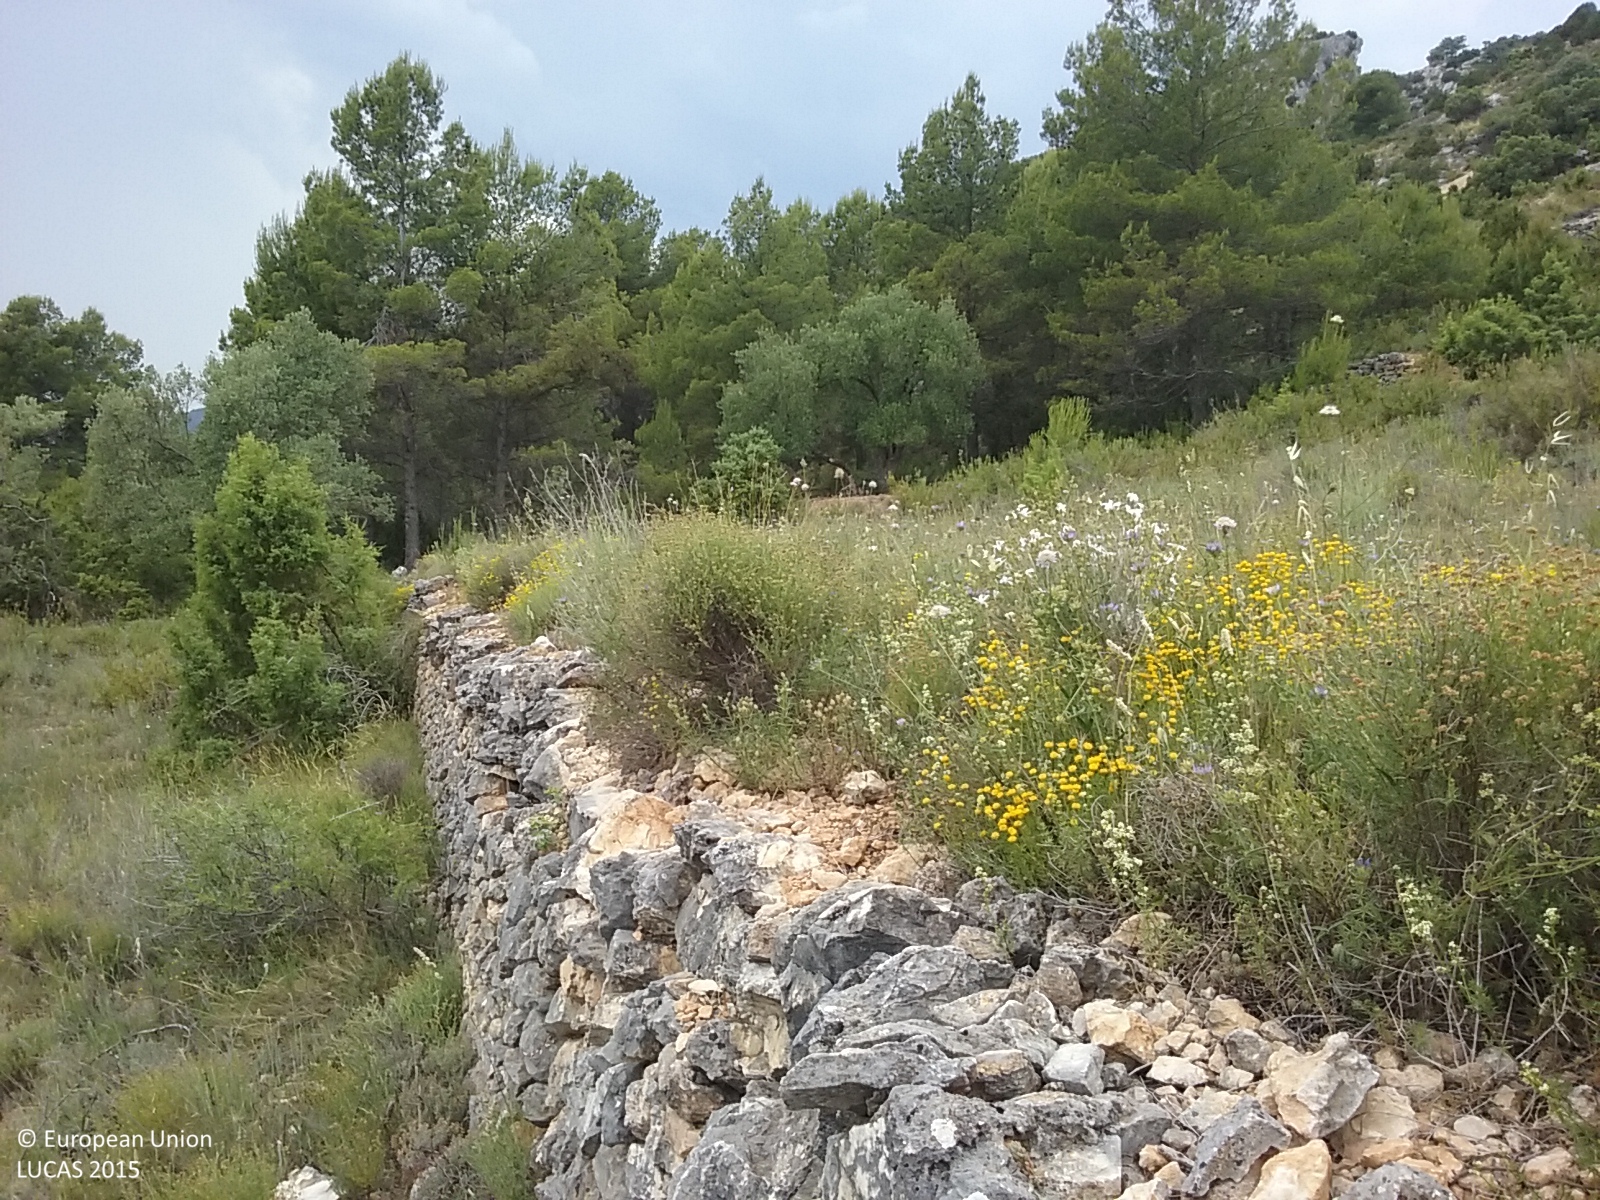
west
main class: Shrubland
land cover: Shrubland without tree cover
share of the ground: 10 - 25 %
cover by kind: herbaceous plants 80 %, shrubs 20 %
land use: Abandoned areas
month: June
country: ES
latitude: 40.8278
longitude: 0.1621
